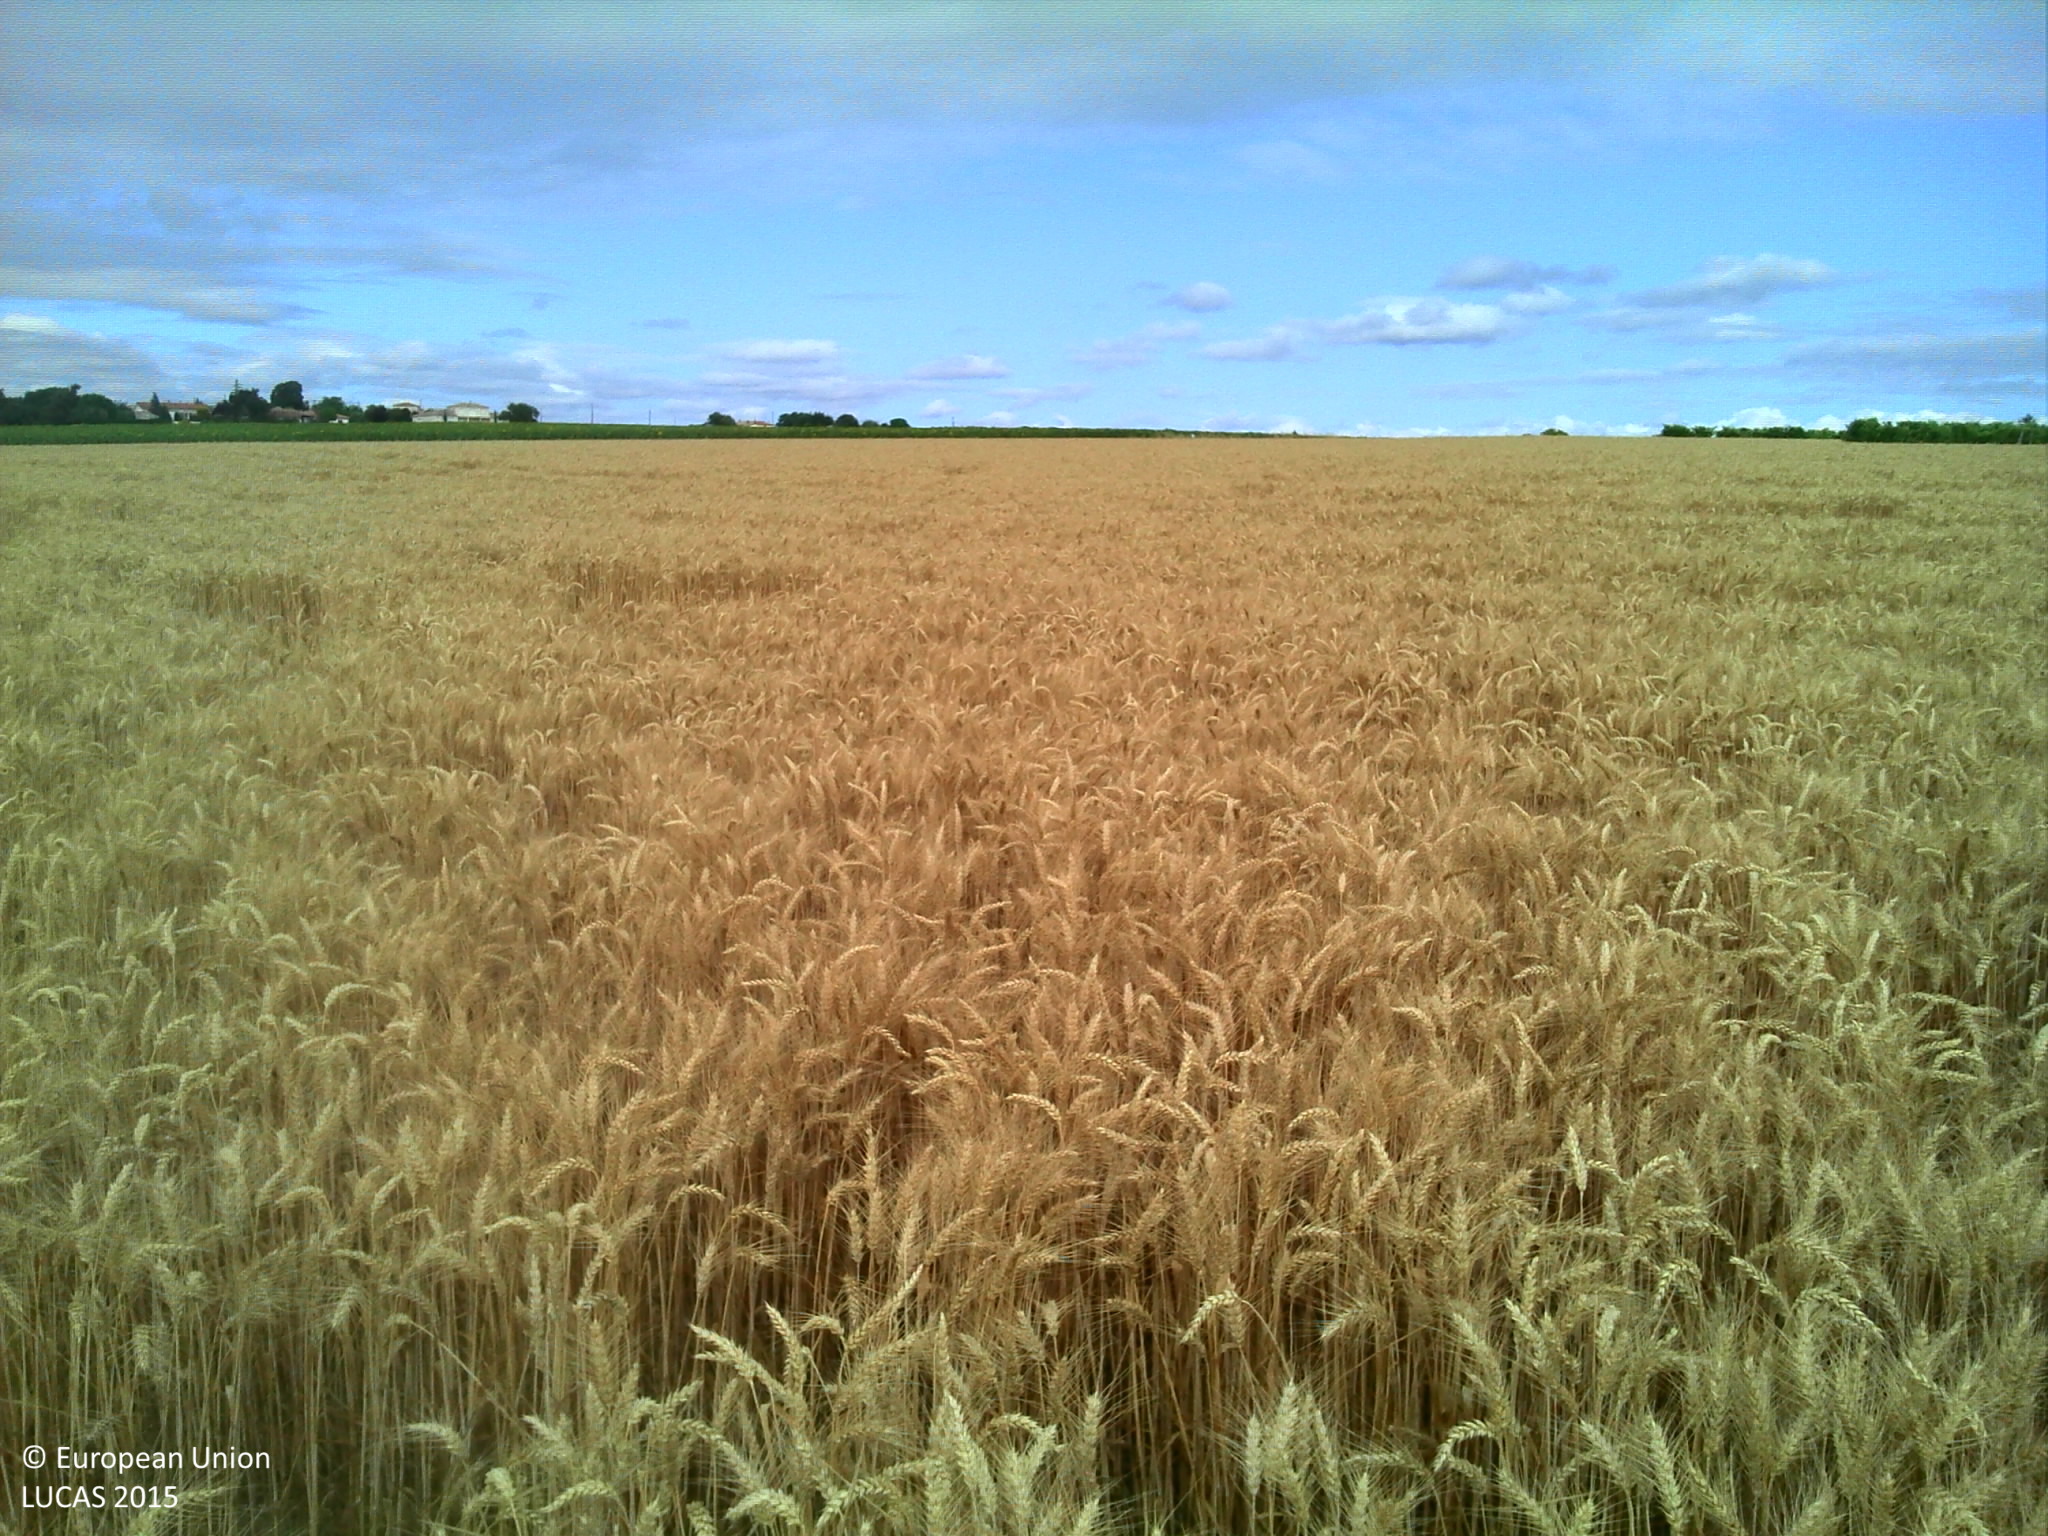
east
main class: Cropland
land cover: Durum wheat
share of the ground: > 75 %
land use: Agriculture (excluding fallow land and kitchen gardens)
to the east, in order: Durum wheat; Fences; Other fresh vegetables; Fences; Grassland without tree/shrub cover; Sunflower
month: July
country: FR
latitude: 45.5079
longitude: -0.8405
